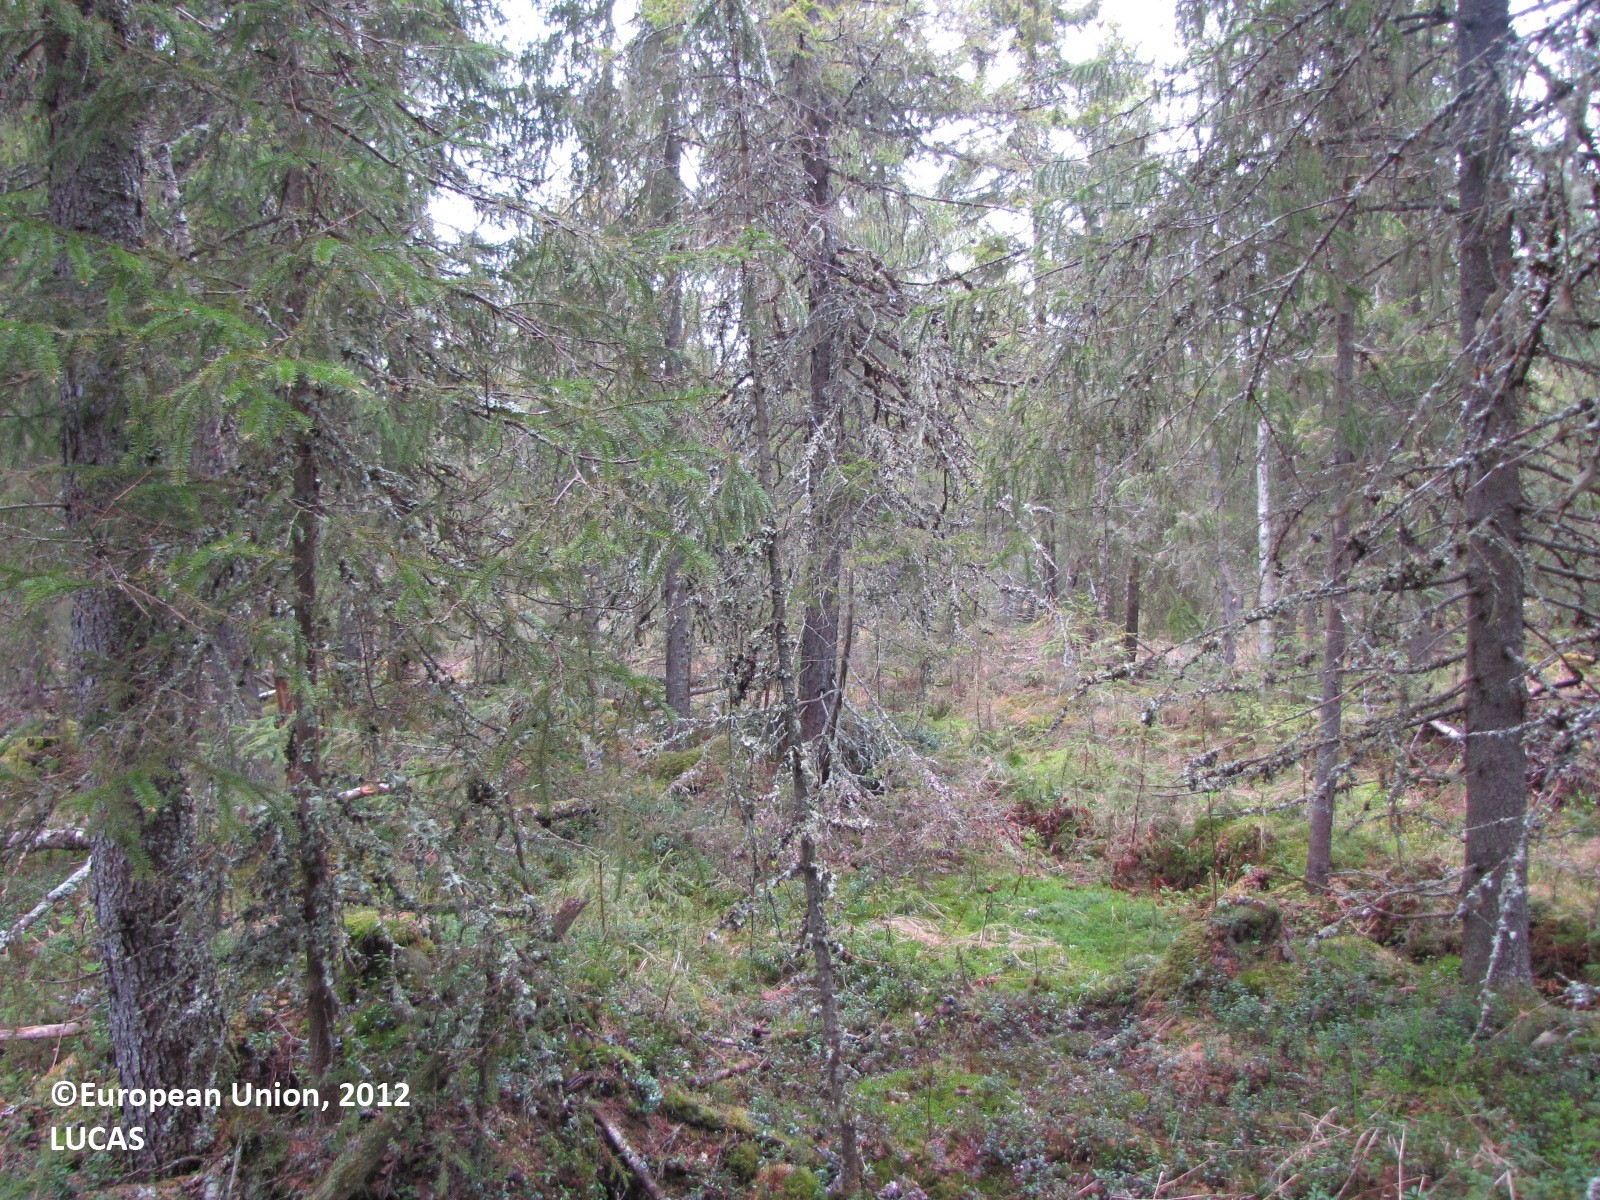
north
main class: Woodland
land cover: Spruce dominated coniferous woodland
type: boreal forest
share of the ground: 50 - 75 %
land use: Forestry
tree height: > 5 m
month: June
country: FI
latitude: 65.9556
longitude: 24.5473
